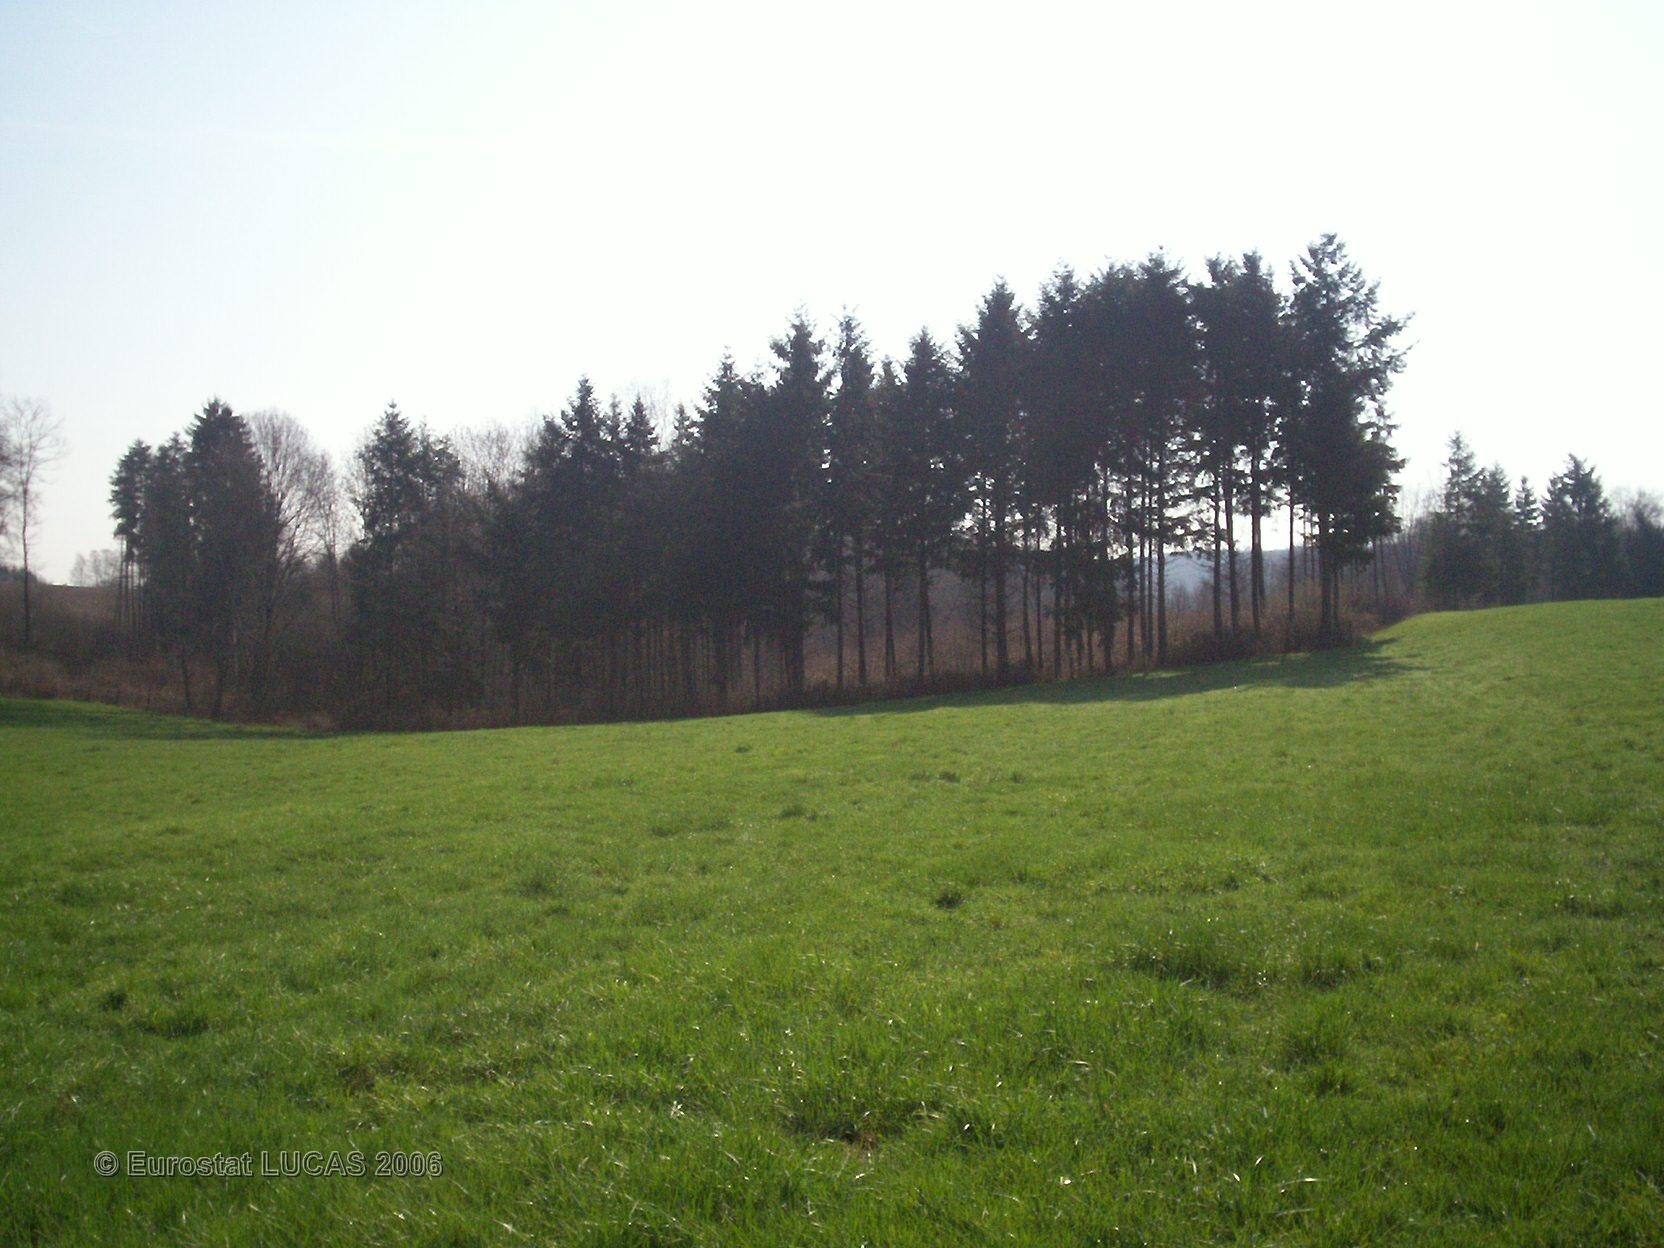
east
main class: Grassland
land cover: Grassland without tree/shrub cover
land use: Agriculture (excluding fallow land and kitchen gardens)
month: April
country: FR
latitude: 48.1625
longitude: 6.3302
